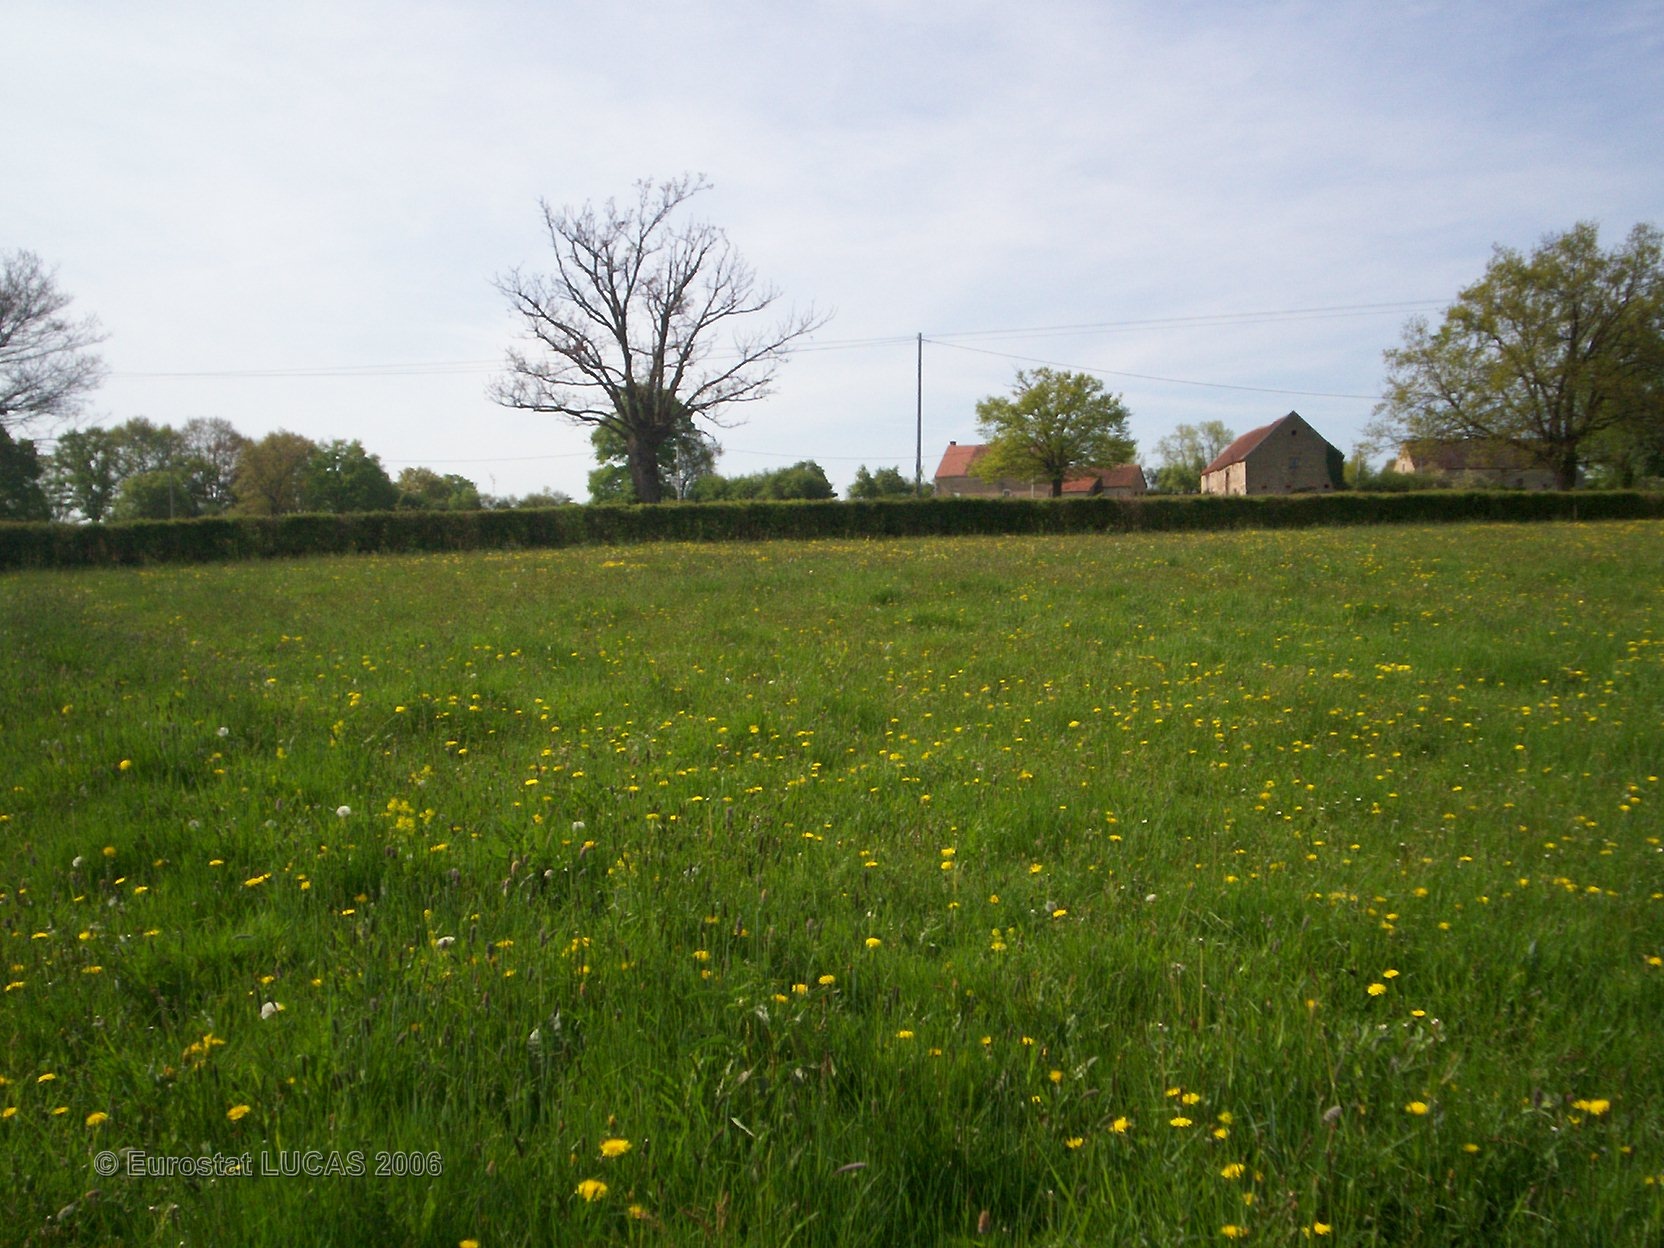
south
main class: Grassland
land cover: Grassland without tree/shrub cover
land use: Agriculture (excluding fallow land and kitchen gardens)
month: May
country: FR
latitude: 46.3321
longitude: 3.1783
